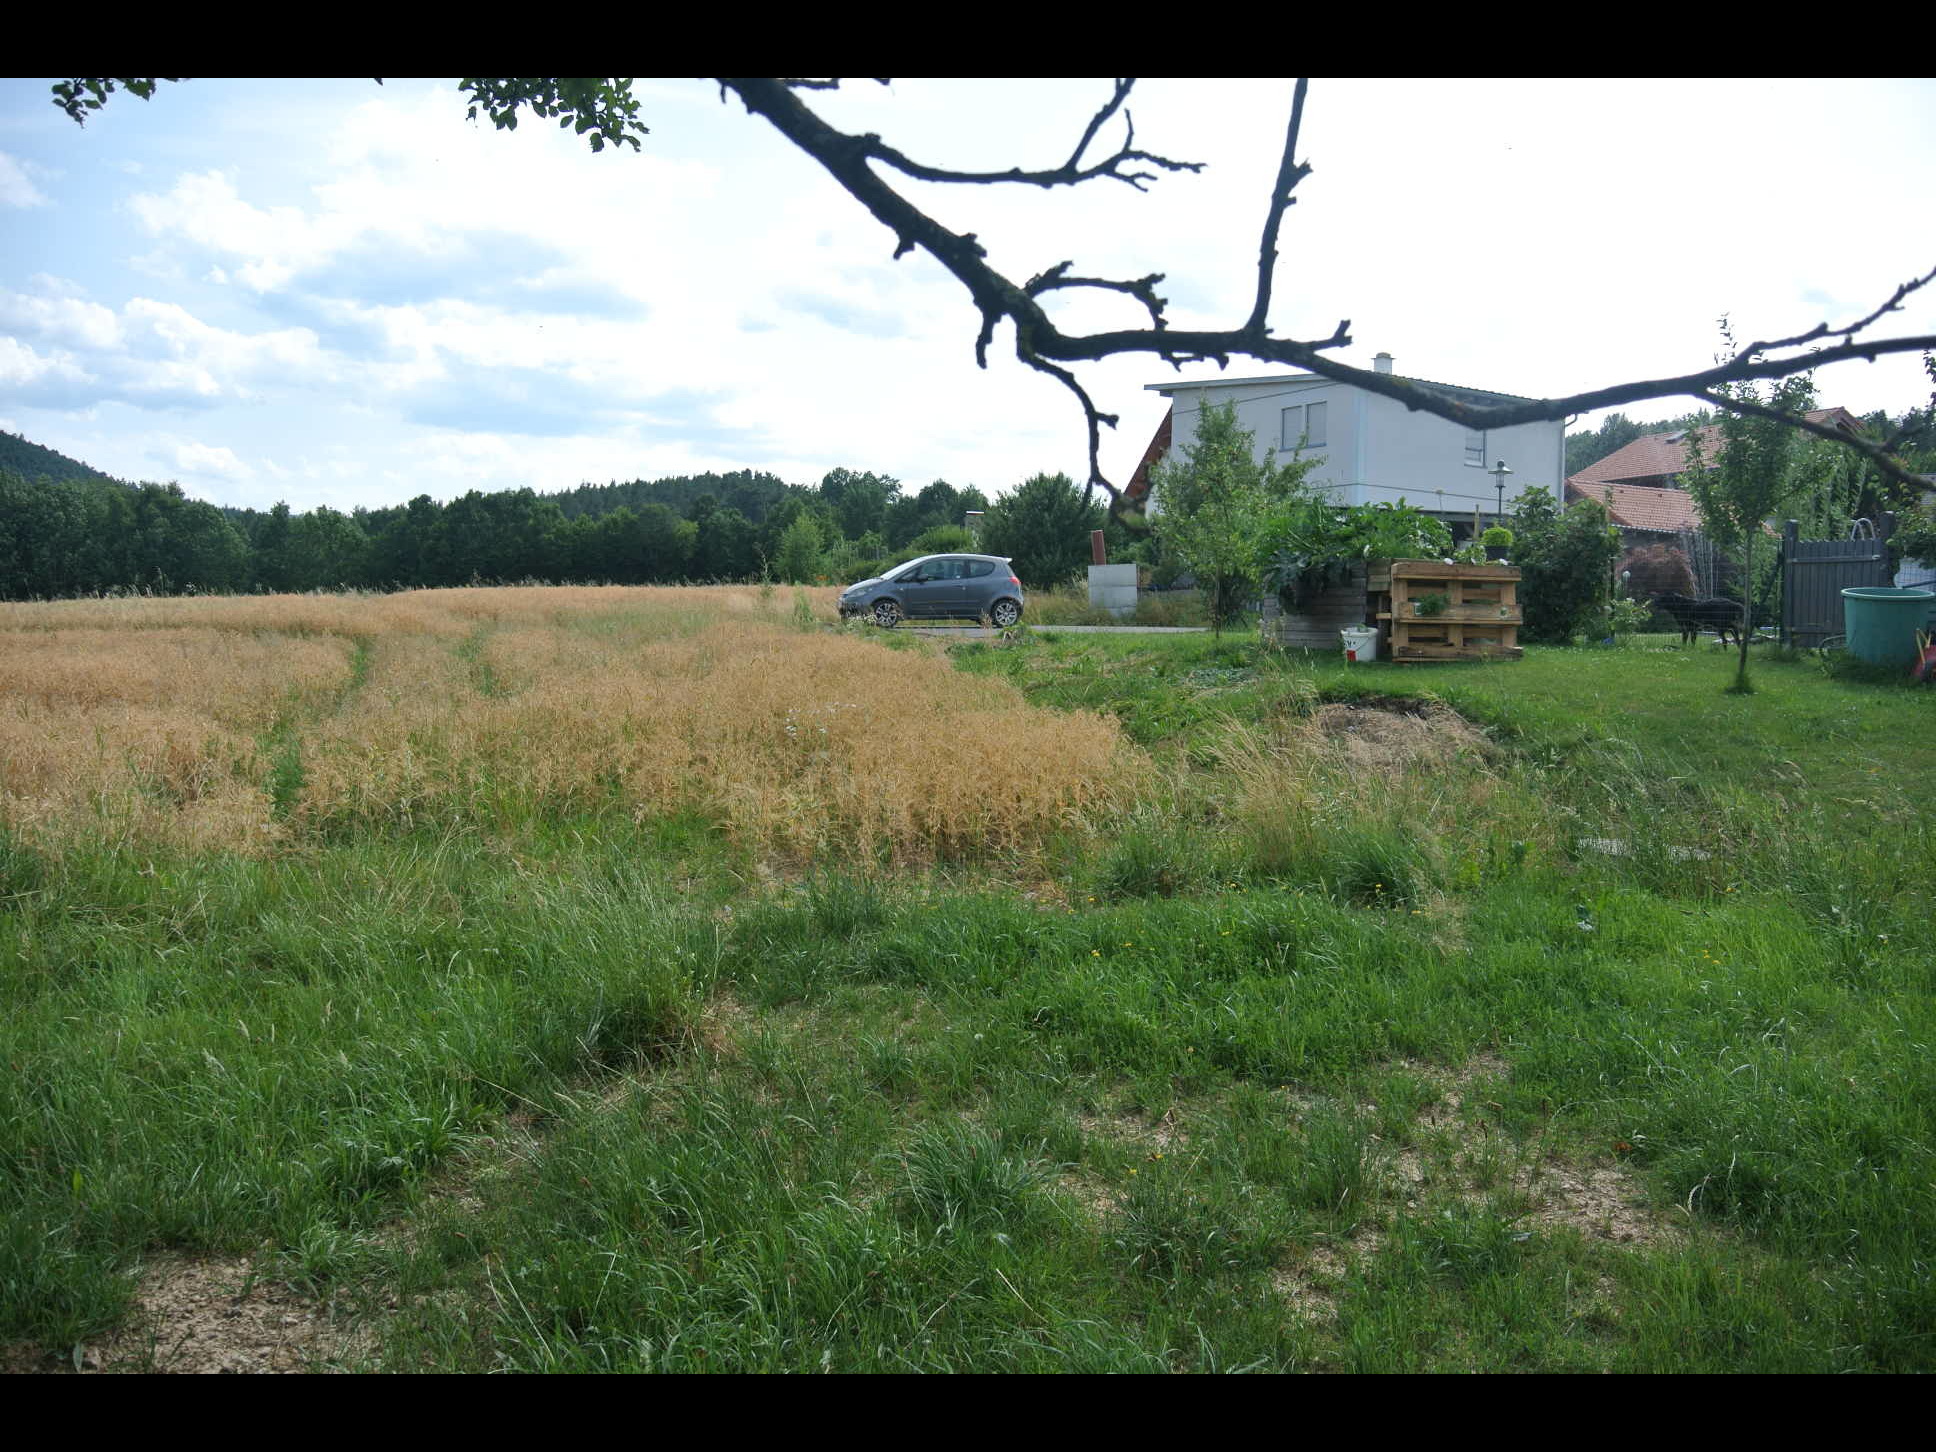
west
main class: Cropland
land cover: Apple fruit
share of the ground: > 75 %
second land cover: Spontaneously vegetated surfaces
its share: > 75 %
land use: Kitchen garden
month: July
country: AT
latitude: 47.6777
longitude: 16.0634
